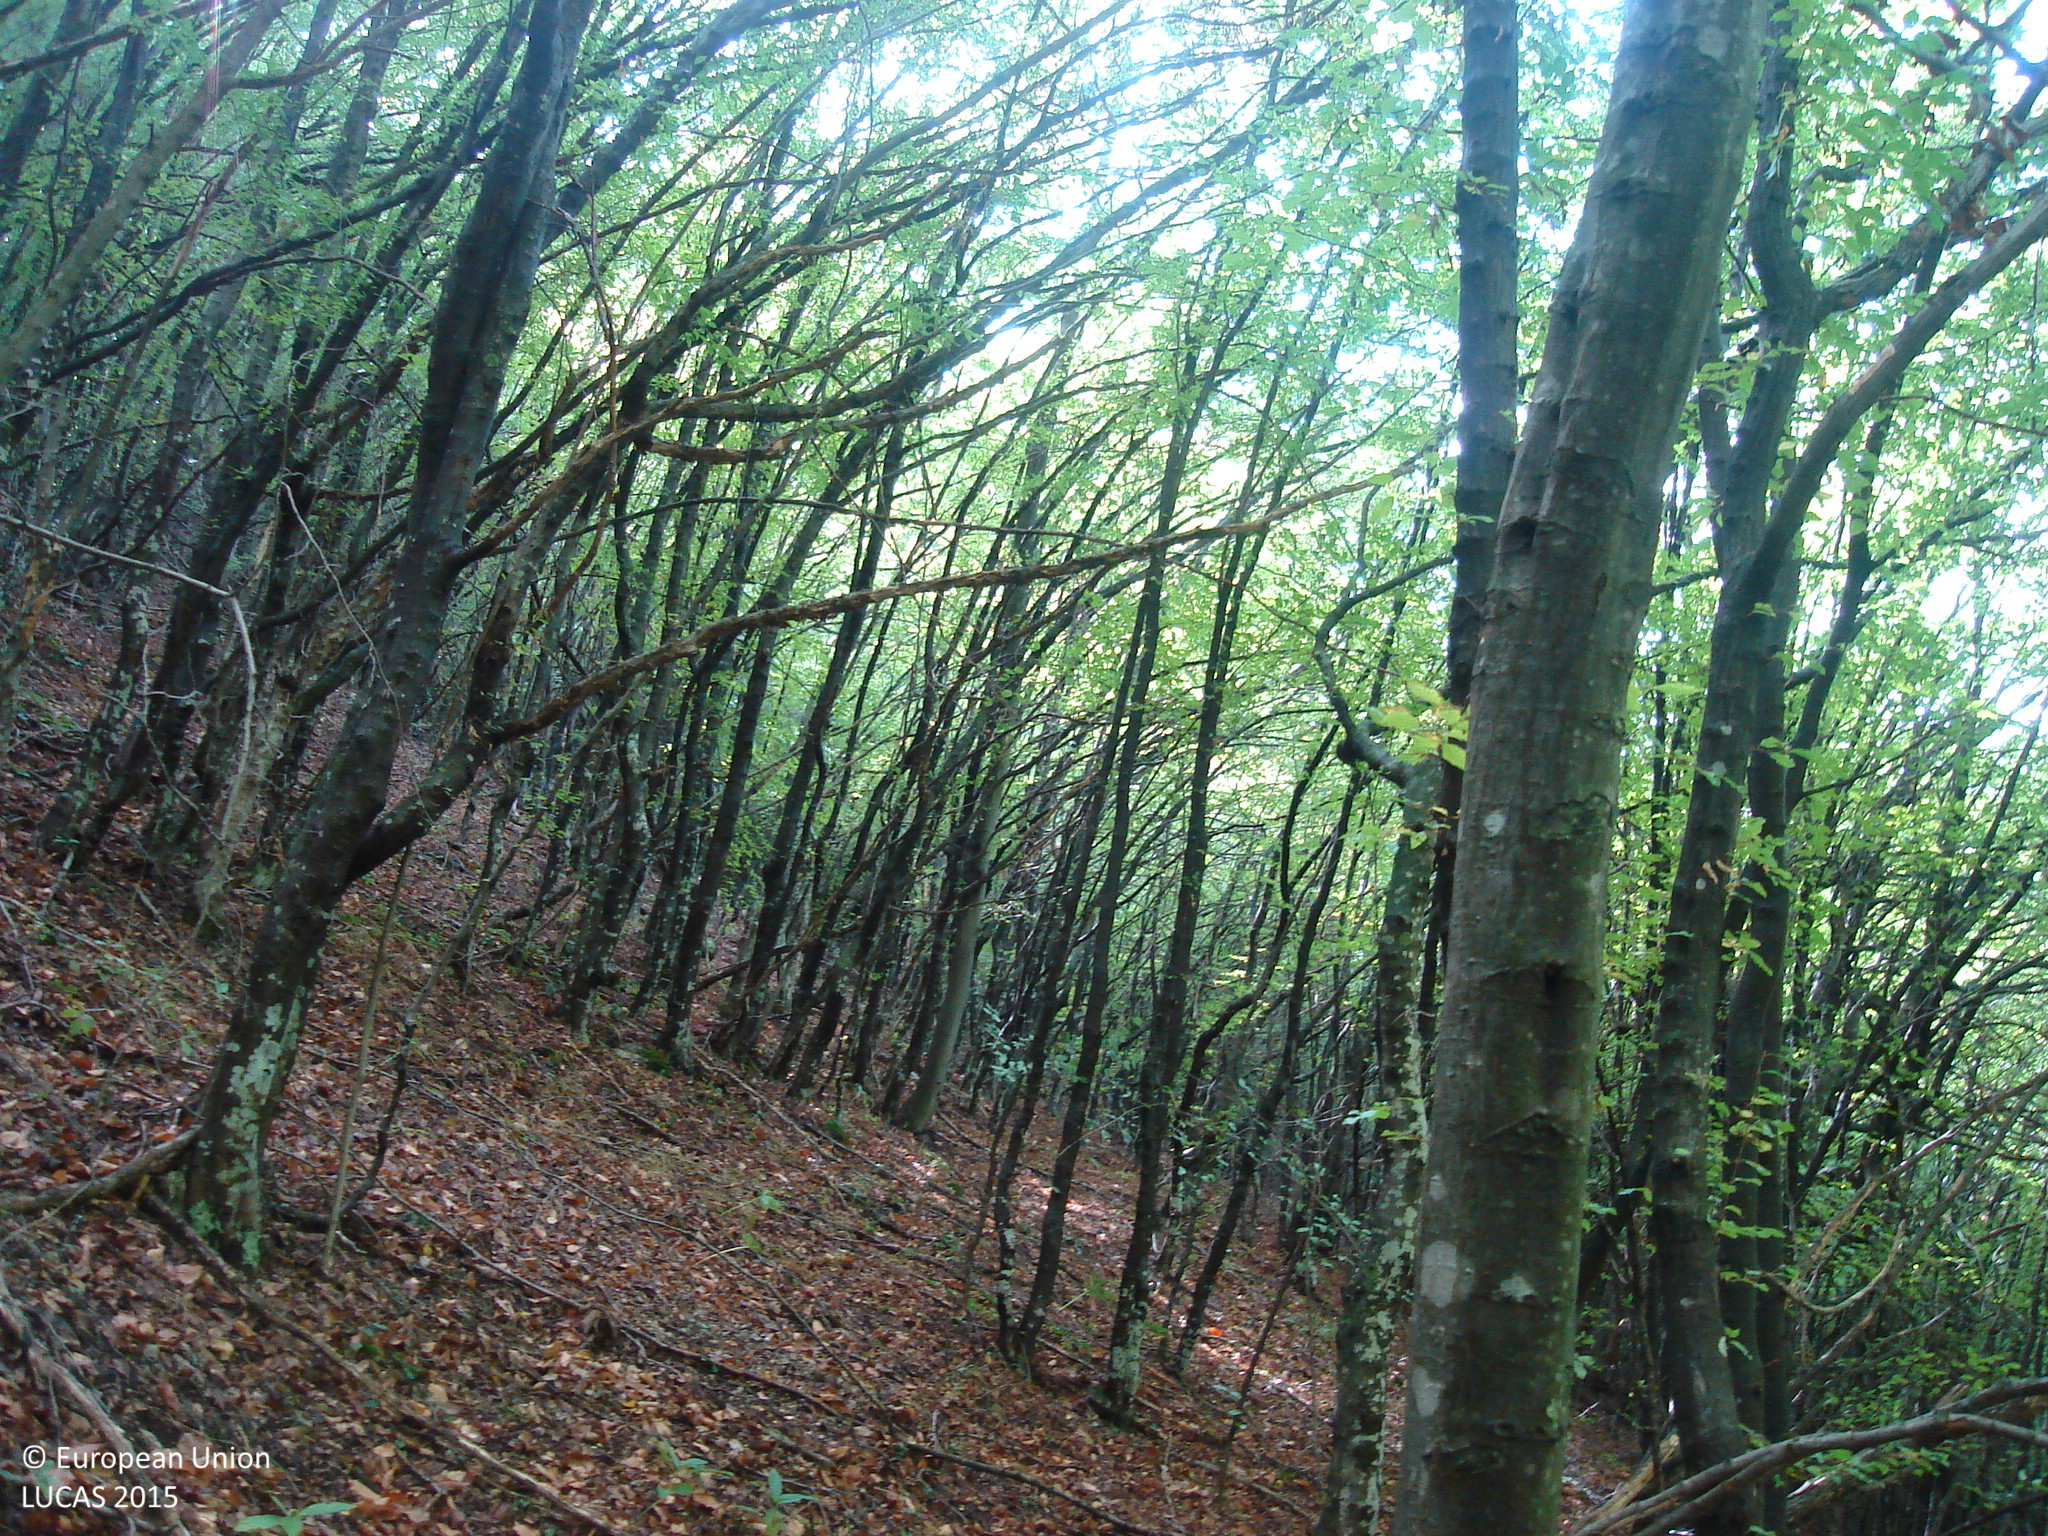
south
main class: Woodland
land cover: Broadleaved woodland
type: beech forest
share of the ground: 50 - 75 %
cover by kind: broadleaved forest trees 70 %, consolidated bare surface 20 %, herbaceous plants 5 %, lichens and mosses 5 %
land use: Forestry
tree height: > 5 m
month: October
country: BG
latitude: 43.0201
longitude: 23.4014
